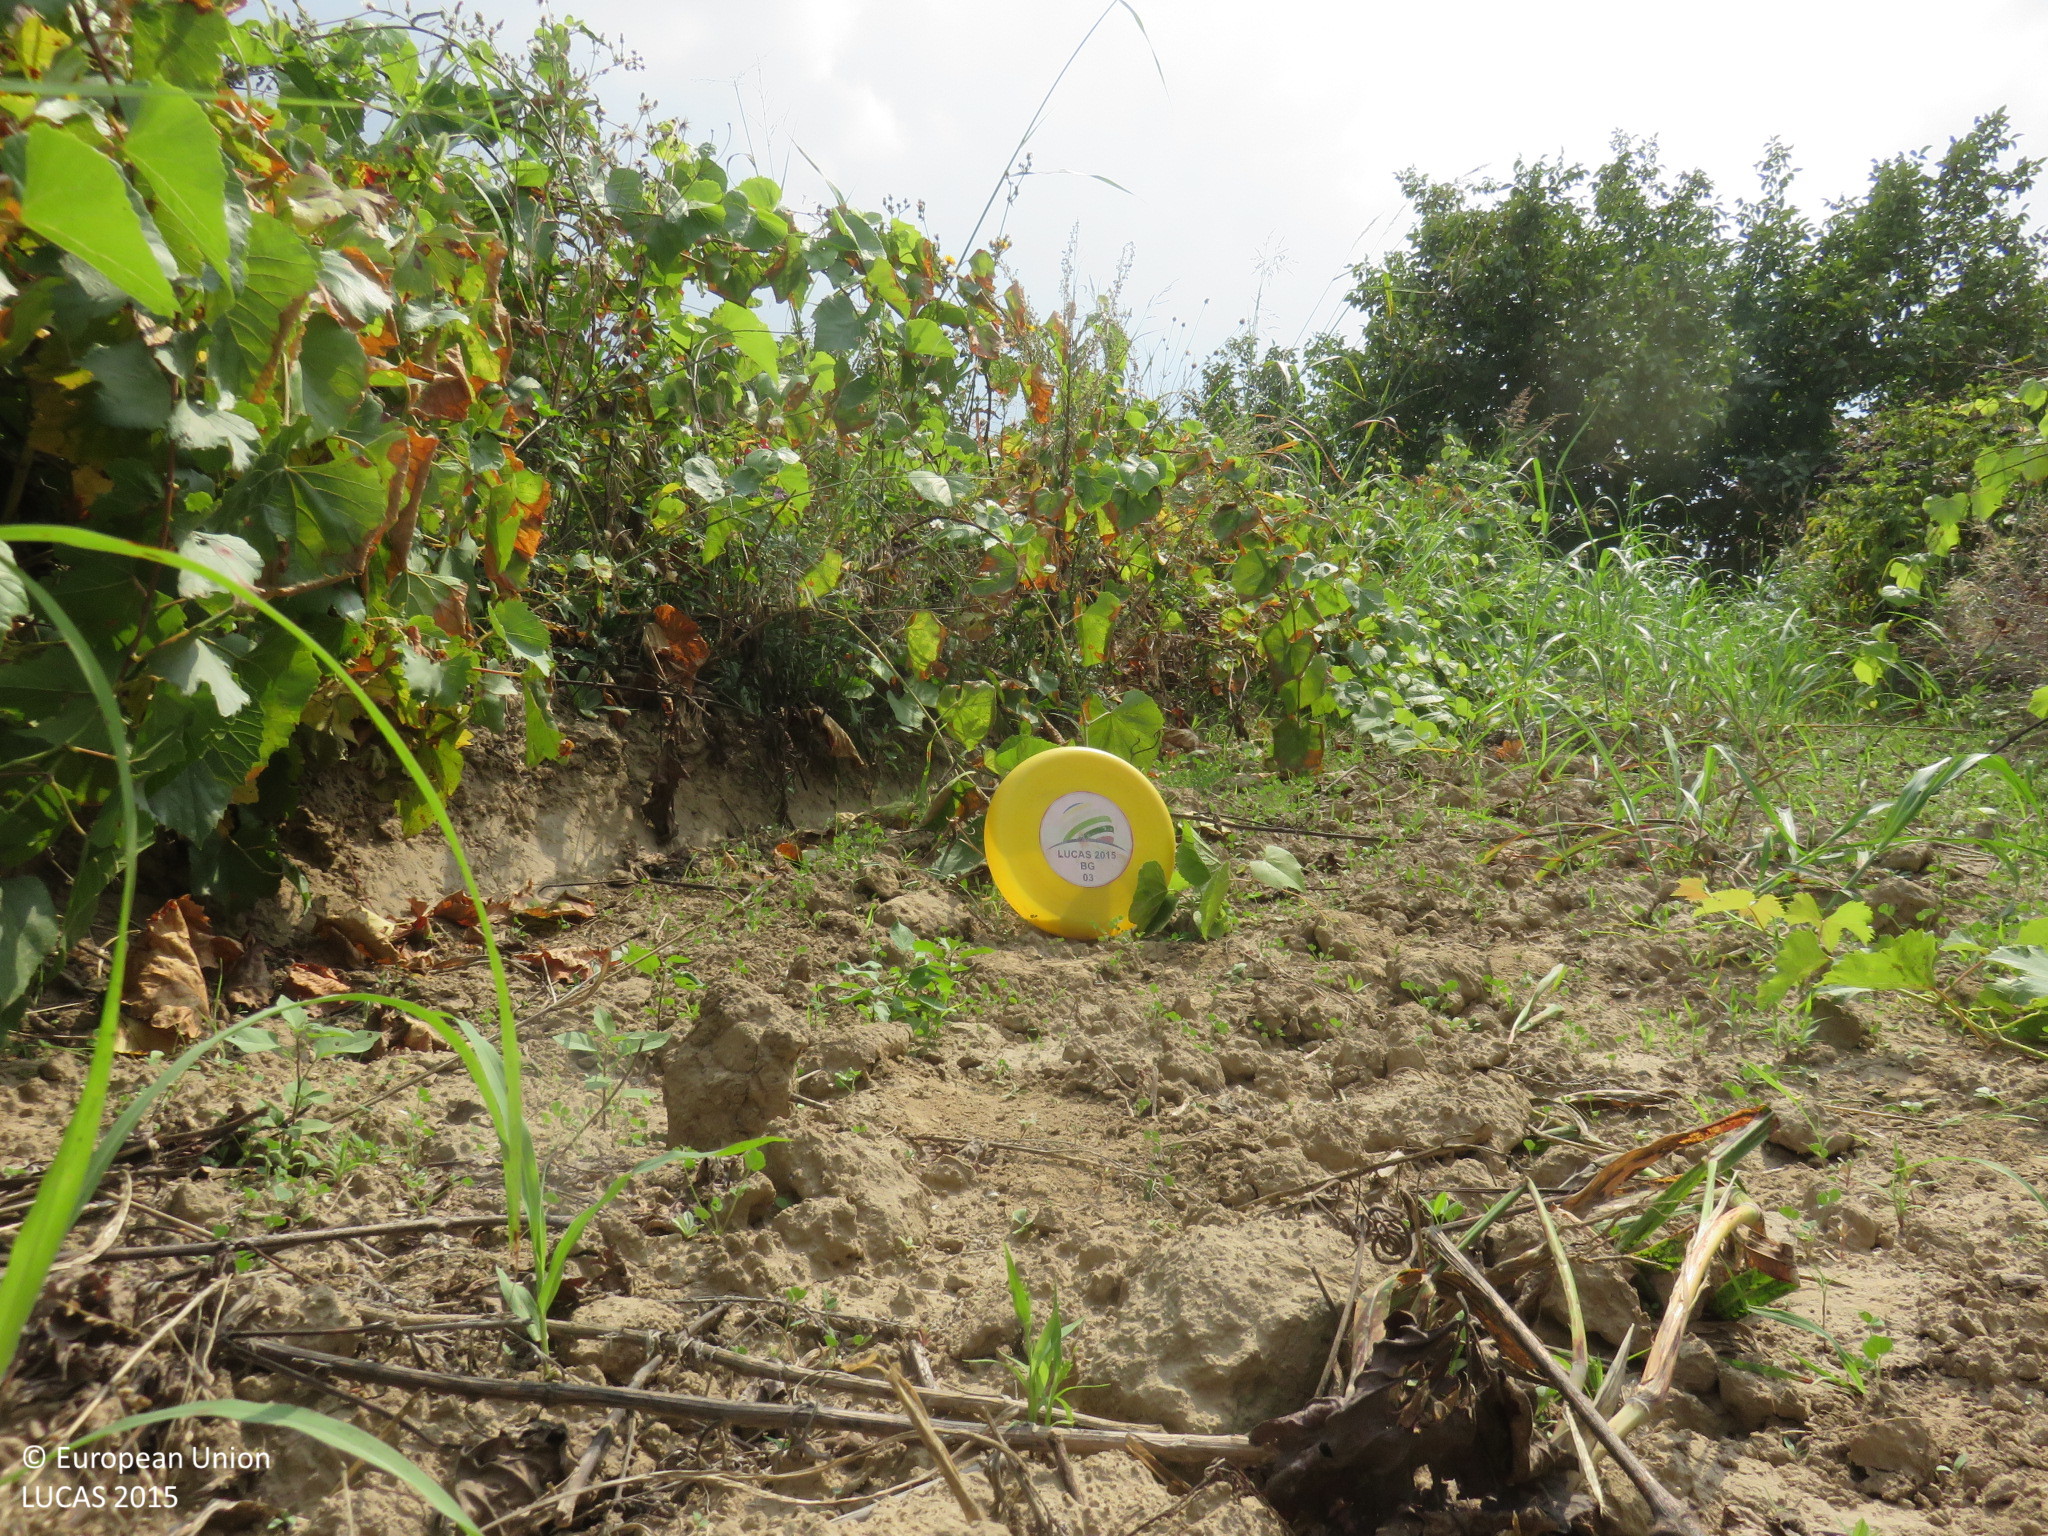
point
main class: Cropland
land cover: Vineyards
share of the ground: > 75 %
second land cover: Spontaneously vegetated surfaces
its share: 25 - 50 %
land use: Agriculture (excluding fallow land and kitchen gardens)
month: September
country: BG
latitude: 43.6118
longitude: 24.9270
